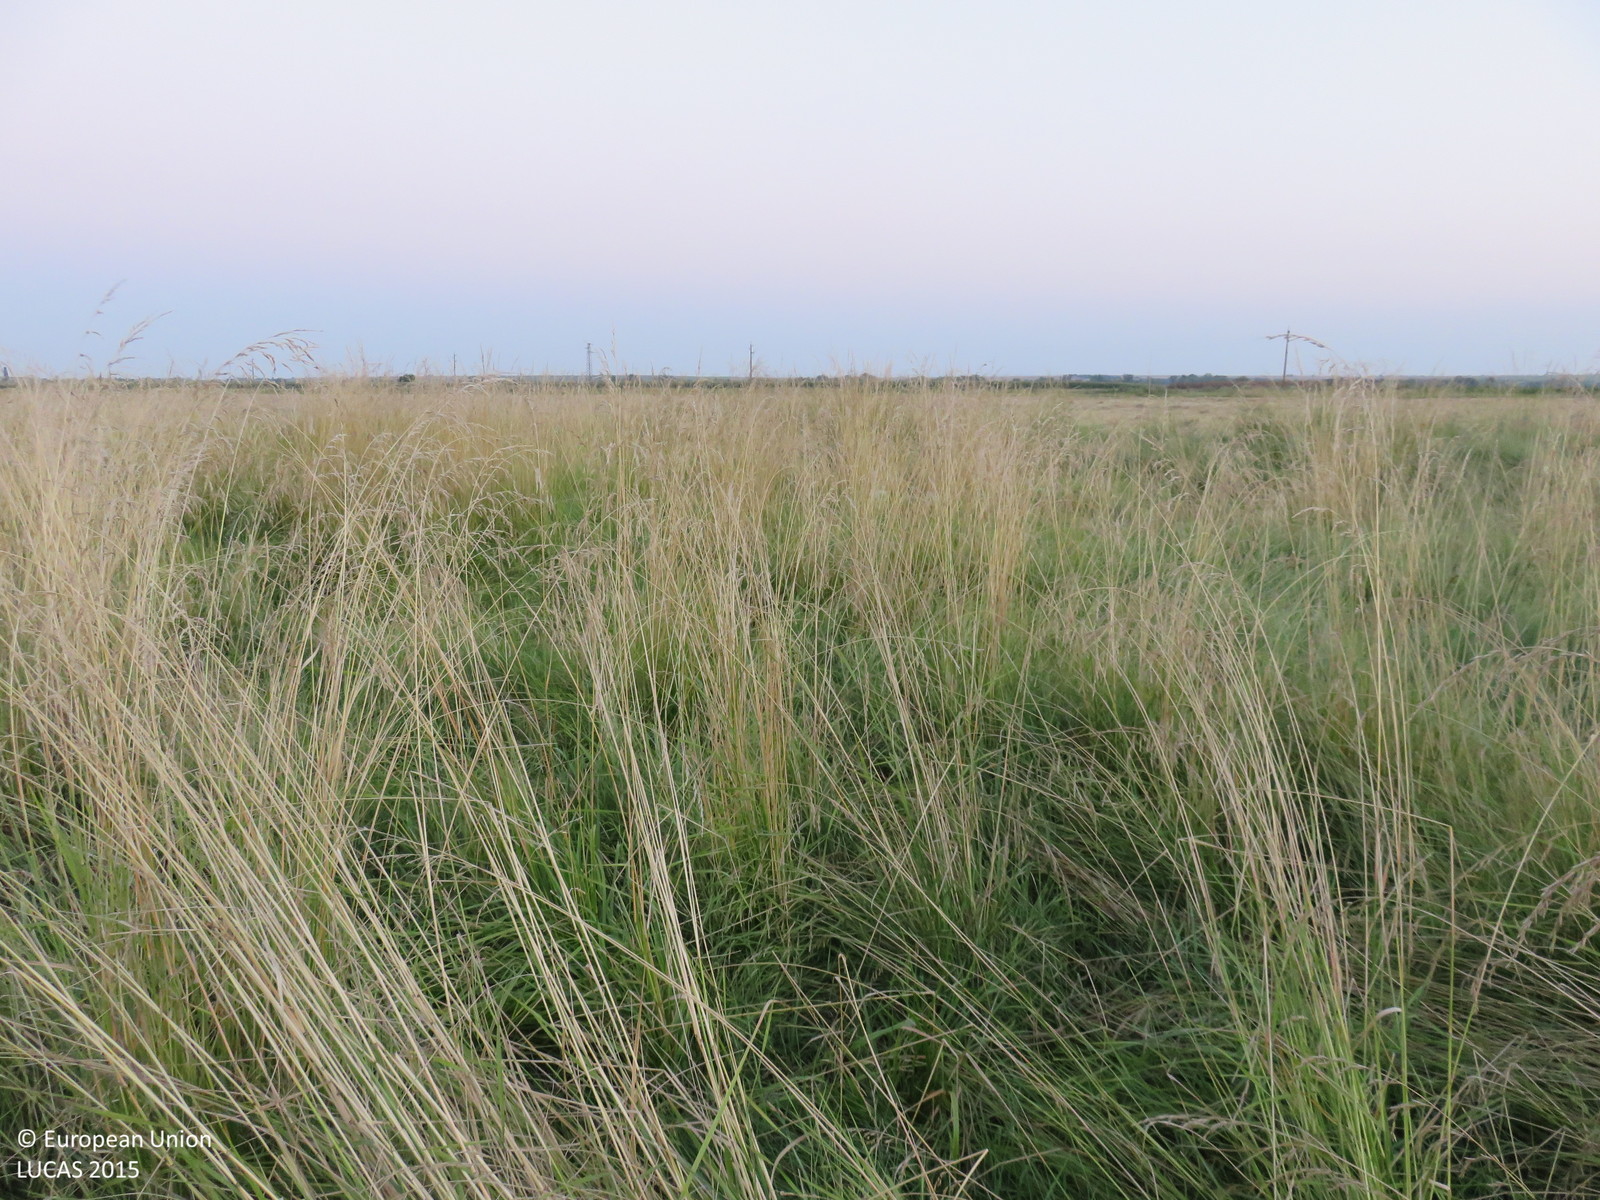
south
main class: Grassland
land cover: Grassland without tree/shrub cover
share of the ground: > 75 %
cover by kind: herbaceous plants 100 %
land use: Agriculture (excluding fallow land and kitchen gardens)
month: July
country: BG
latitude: 43.4668
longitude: 25.0405
